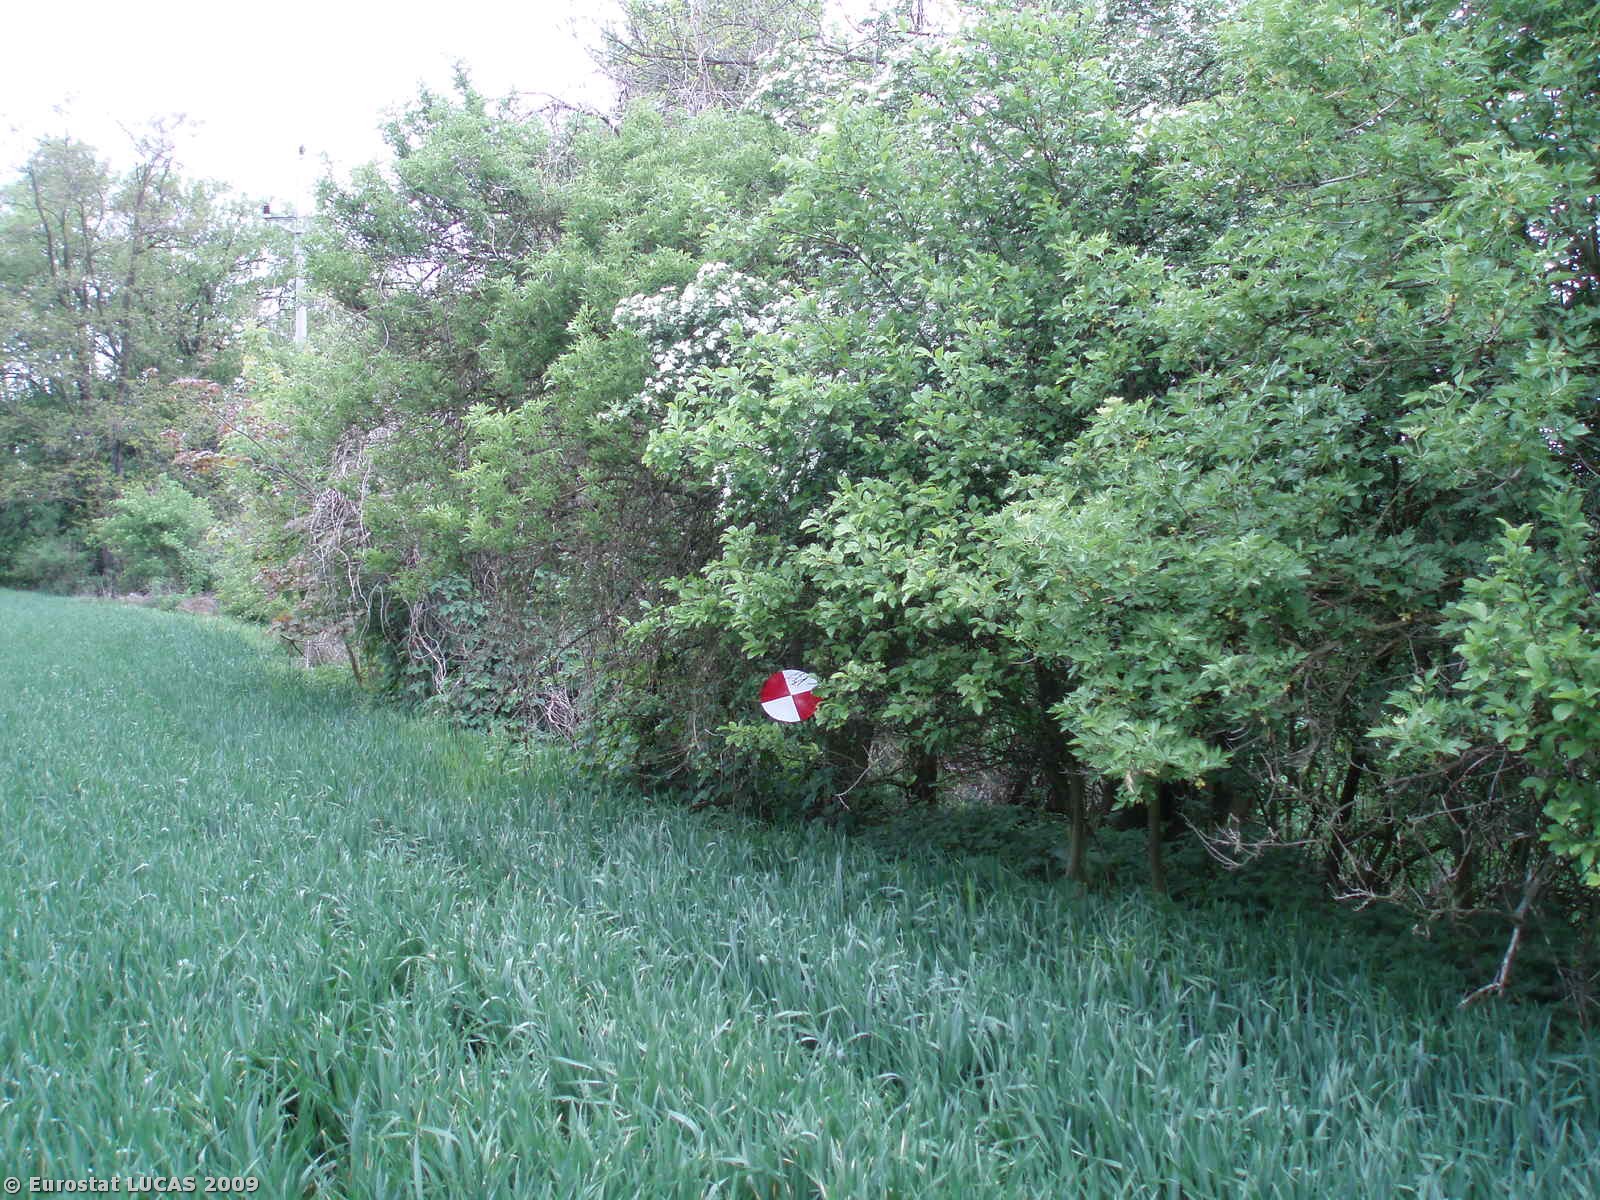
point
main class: Woodland
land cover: Broadleaved woodland
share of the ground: > 75 %
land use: Unused
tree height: > 5 m
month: May
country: CZ
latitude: 50.2163
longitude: 14.1634
